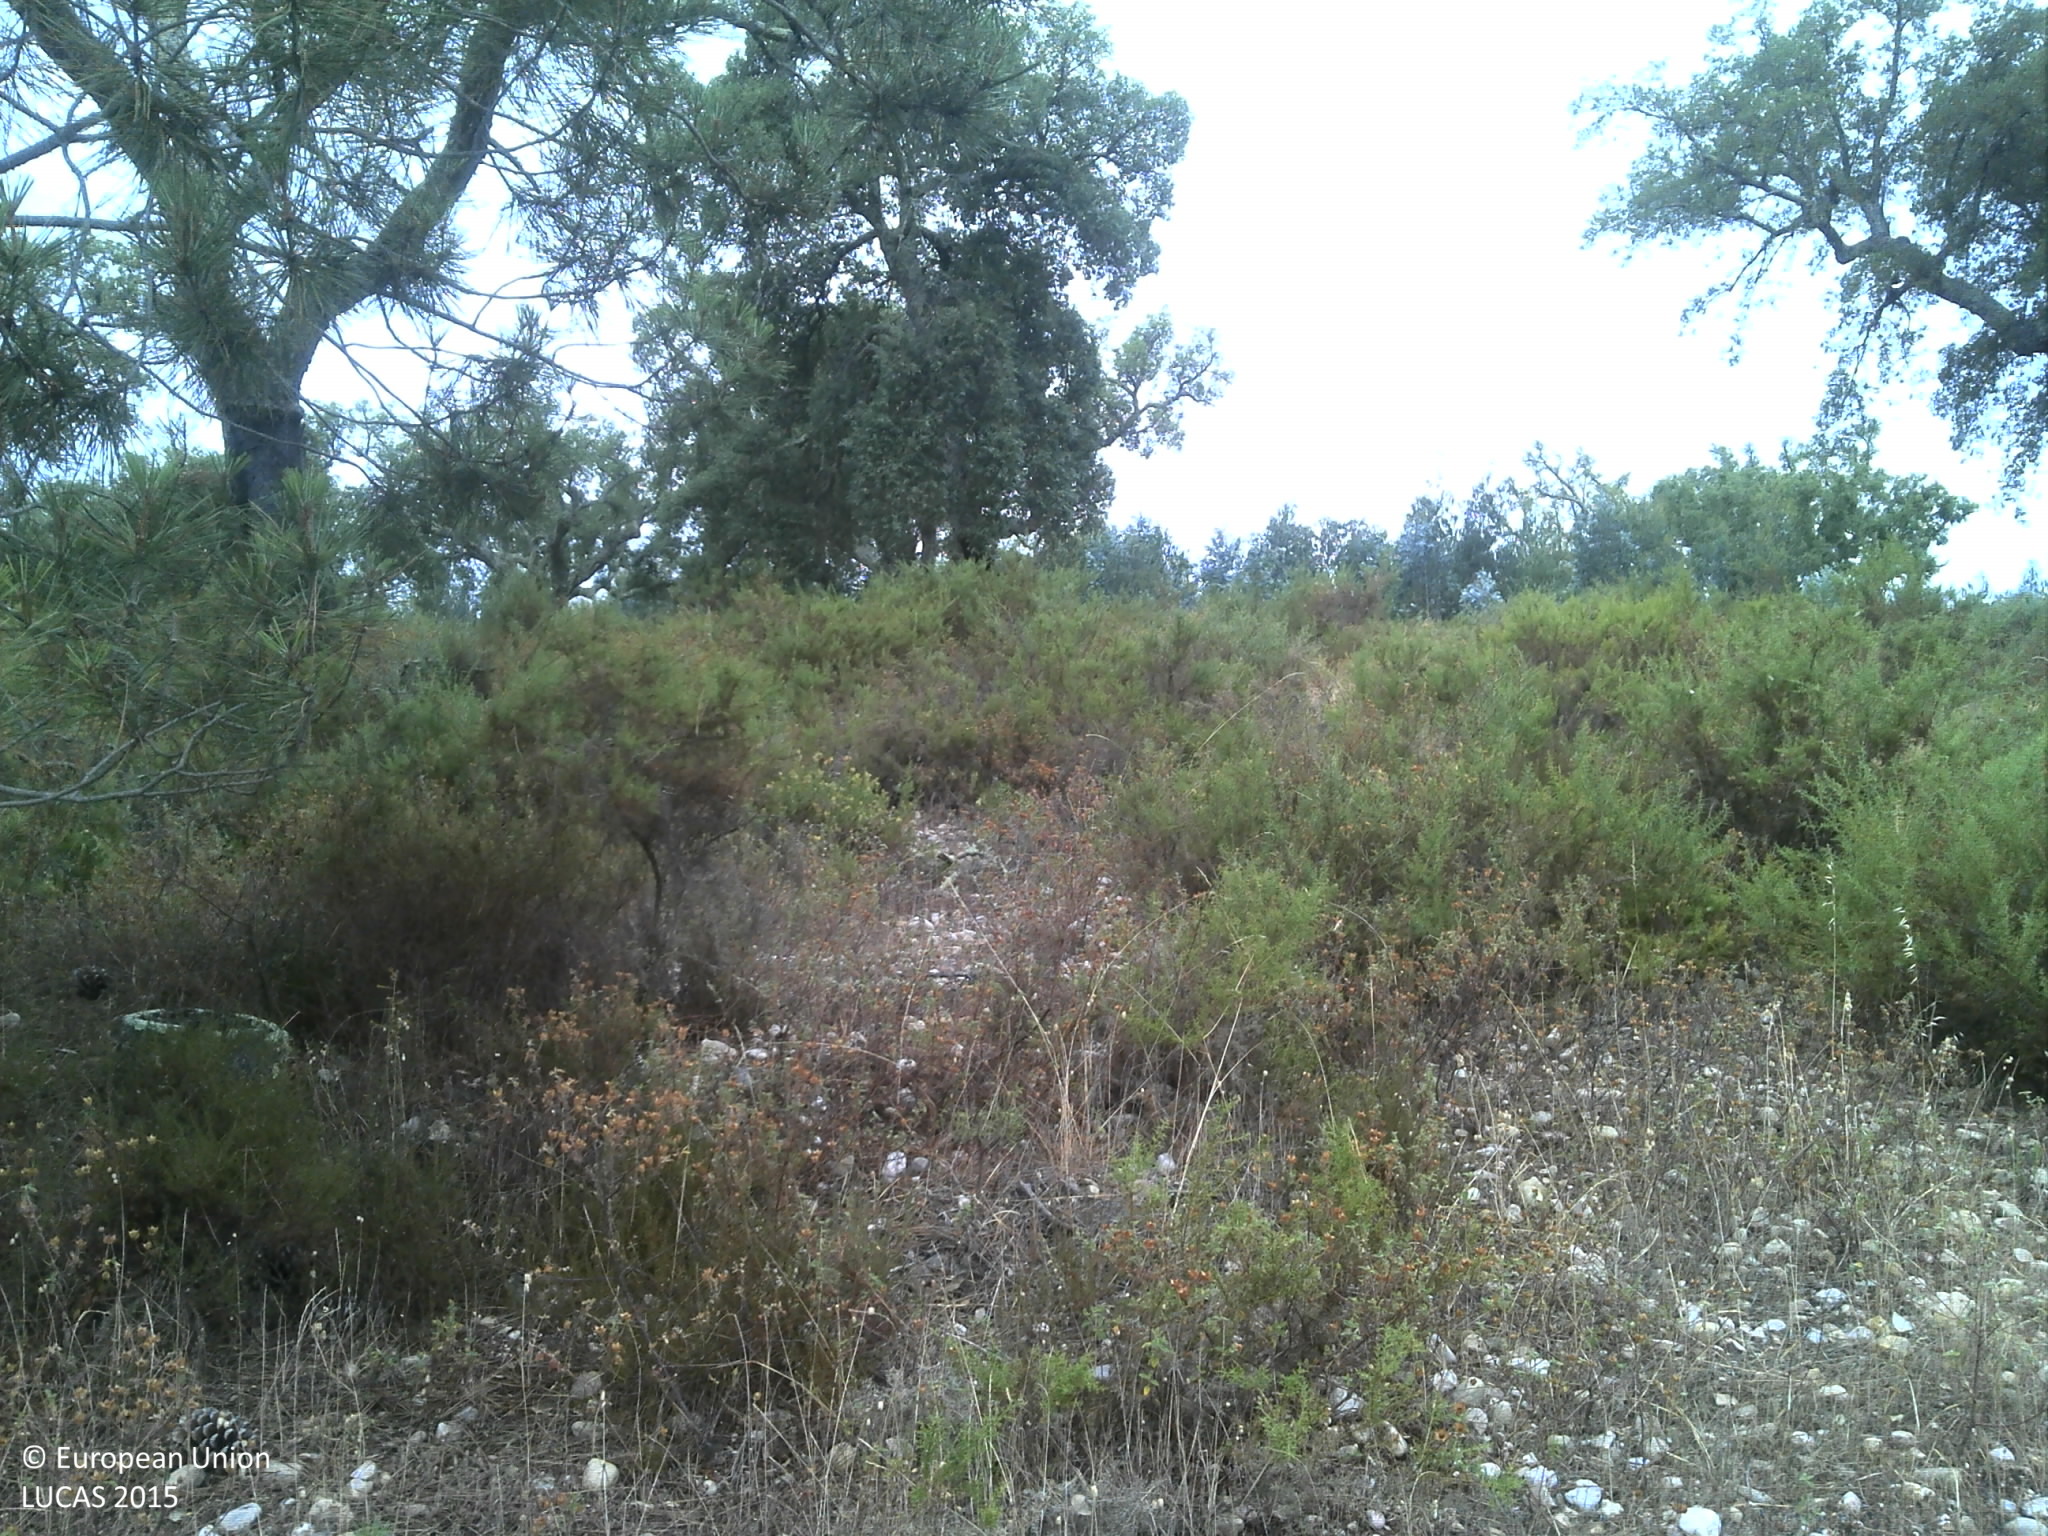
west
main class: Woodland
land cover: Broadleaved woodland
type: broadleaved evergreen forest
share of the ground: 25 - 50 %
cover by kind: broadleaved forest trees 50 %, unconsolidated bare surface 25 %, herbaceous plants 20 %, shrubs 5 %
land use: Forestry
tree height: > 5 m
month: June
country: PT
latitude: 39.2824
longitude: -8.0367
